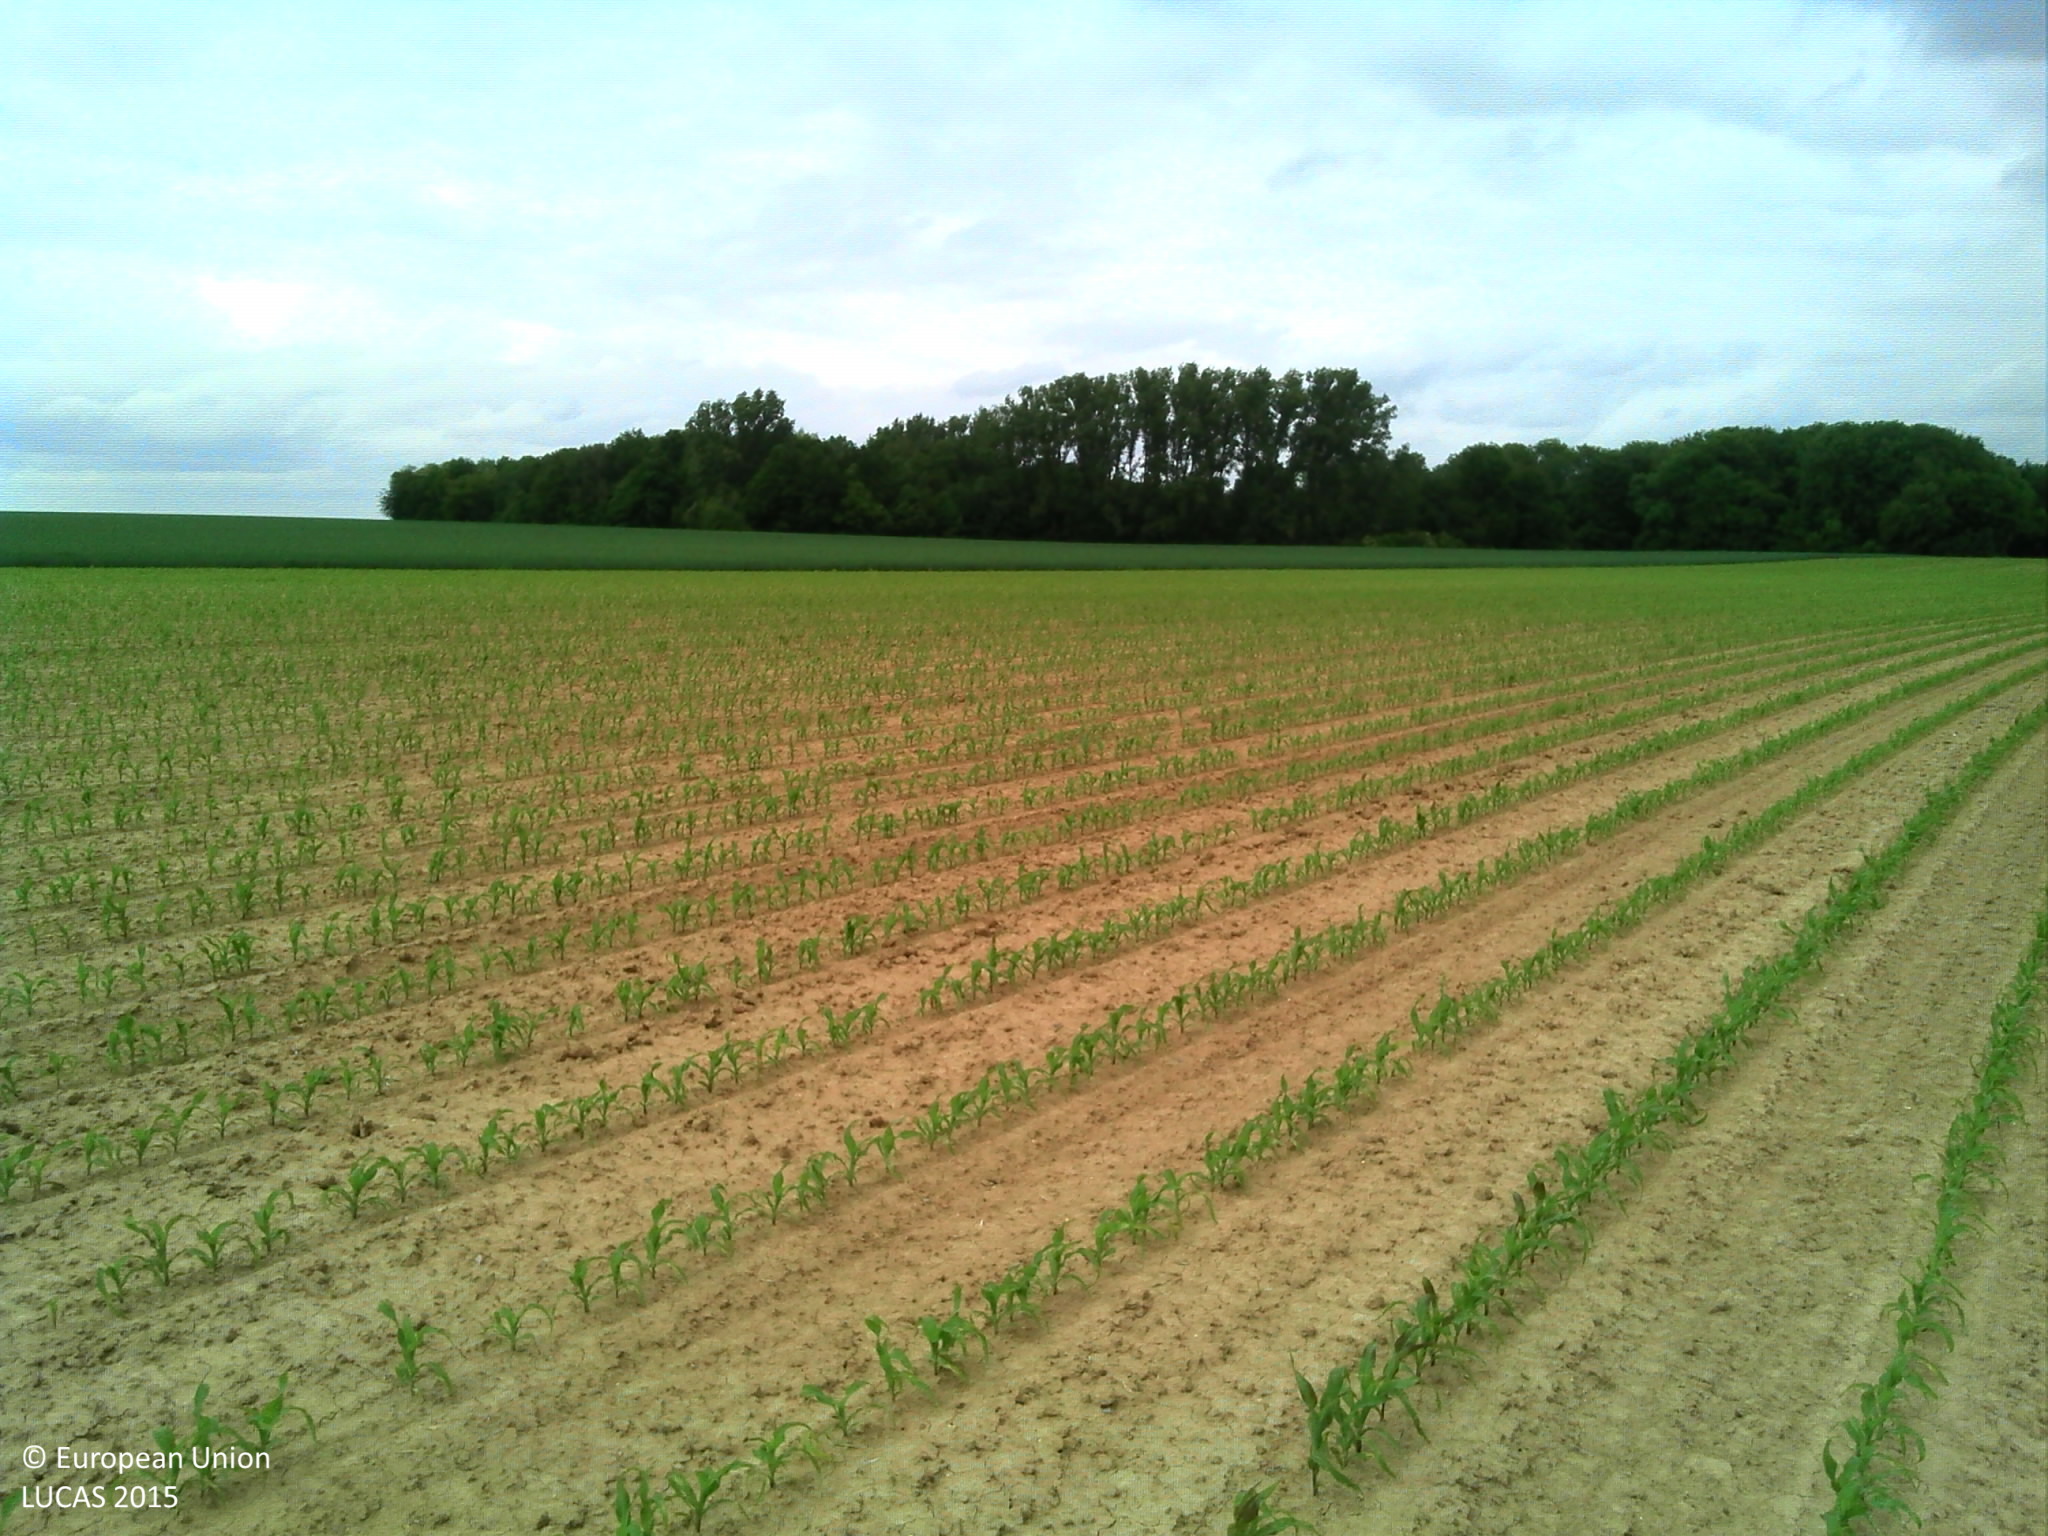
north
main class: Cropland
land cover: Maize
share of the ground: < 10 %
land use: Agriculture (excluding fallow land and kitchen gardens)
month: May
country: FR
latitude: 49.8754
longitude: 3.2426
